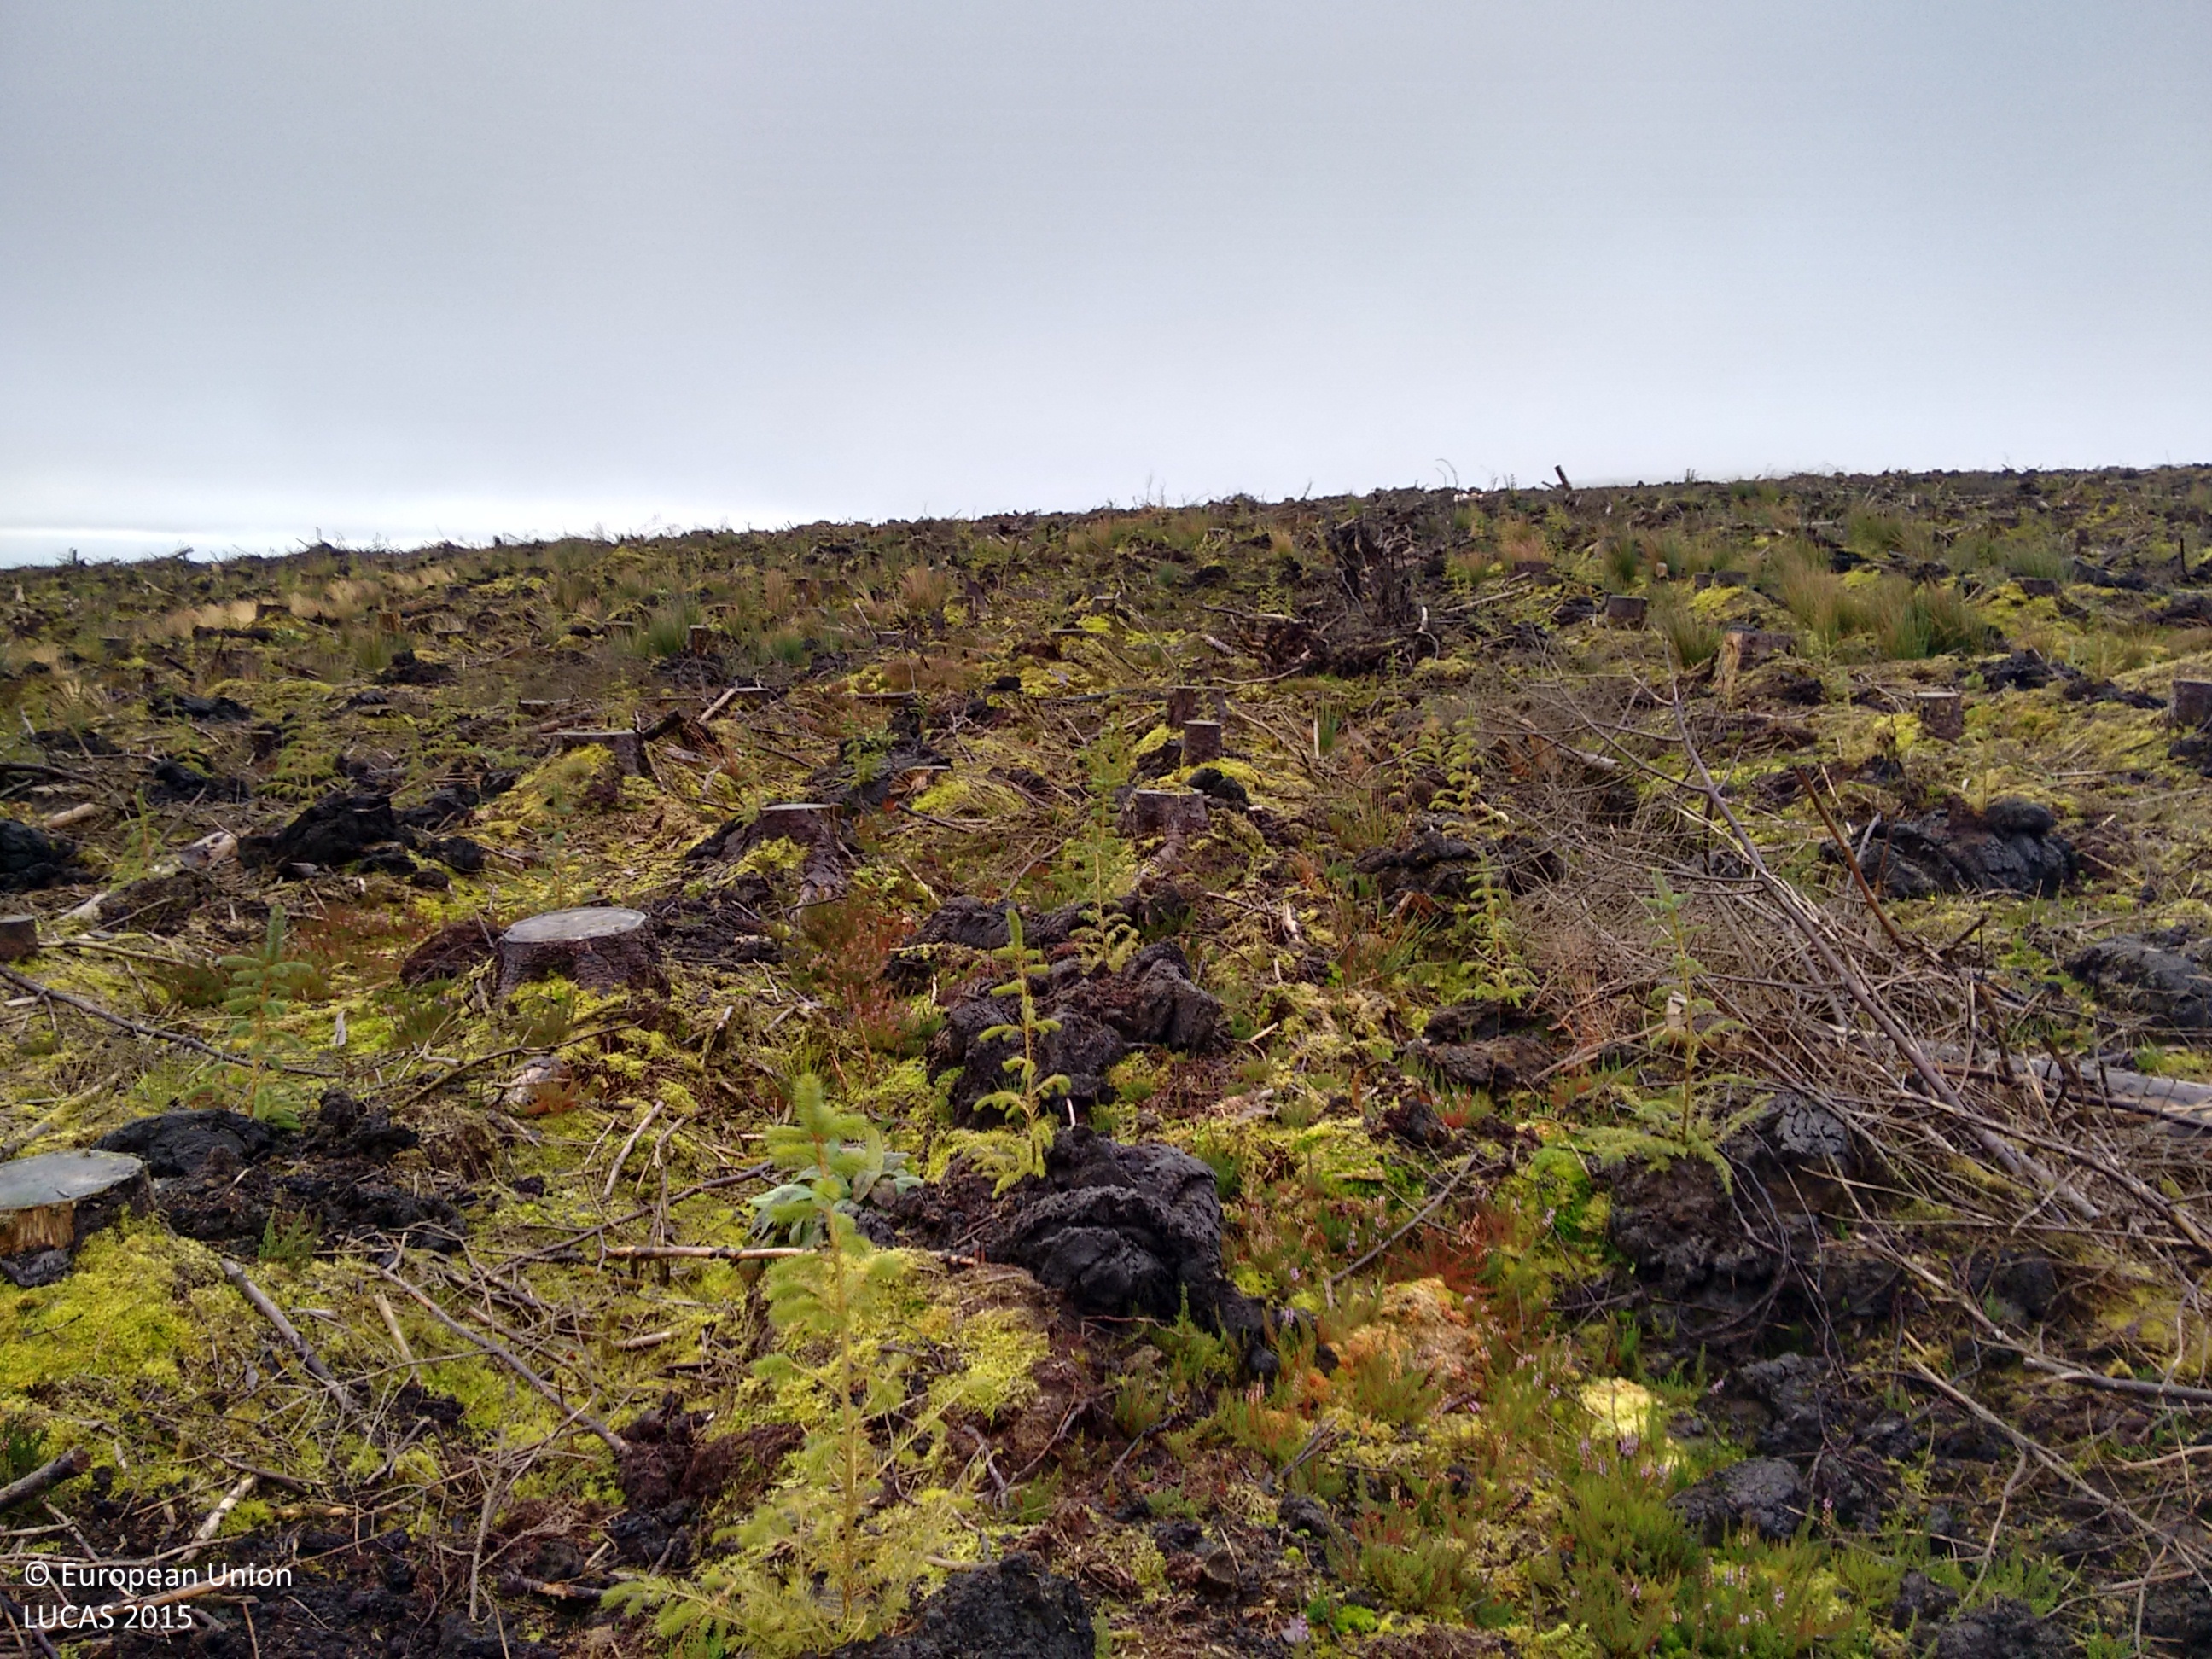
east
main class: Shrubland
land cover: Shrubland without tree cover
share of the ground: > 75 %
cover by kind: shrubs 80 %, lichens and mosses 20 %
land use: Forestry
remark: Clear cut
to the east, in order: Shrubland without tree cover; Tracks; Shrubland without tree cover
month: October
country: GB
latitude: 54.5785
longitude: -7.5306
